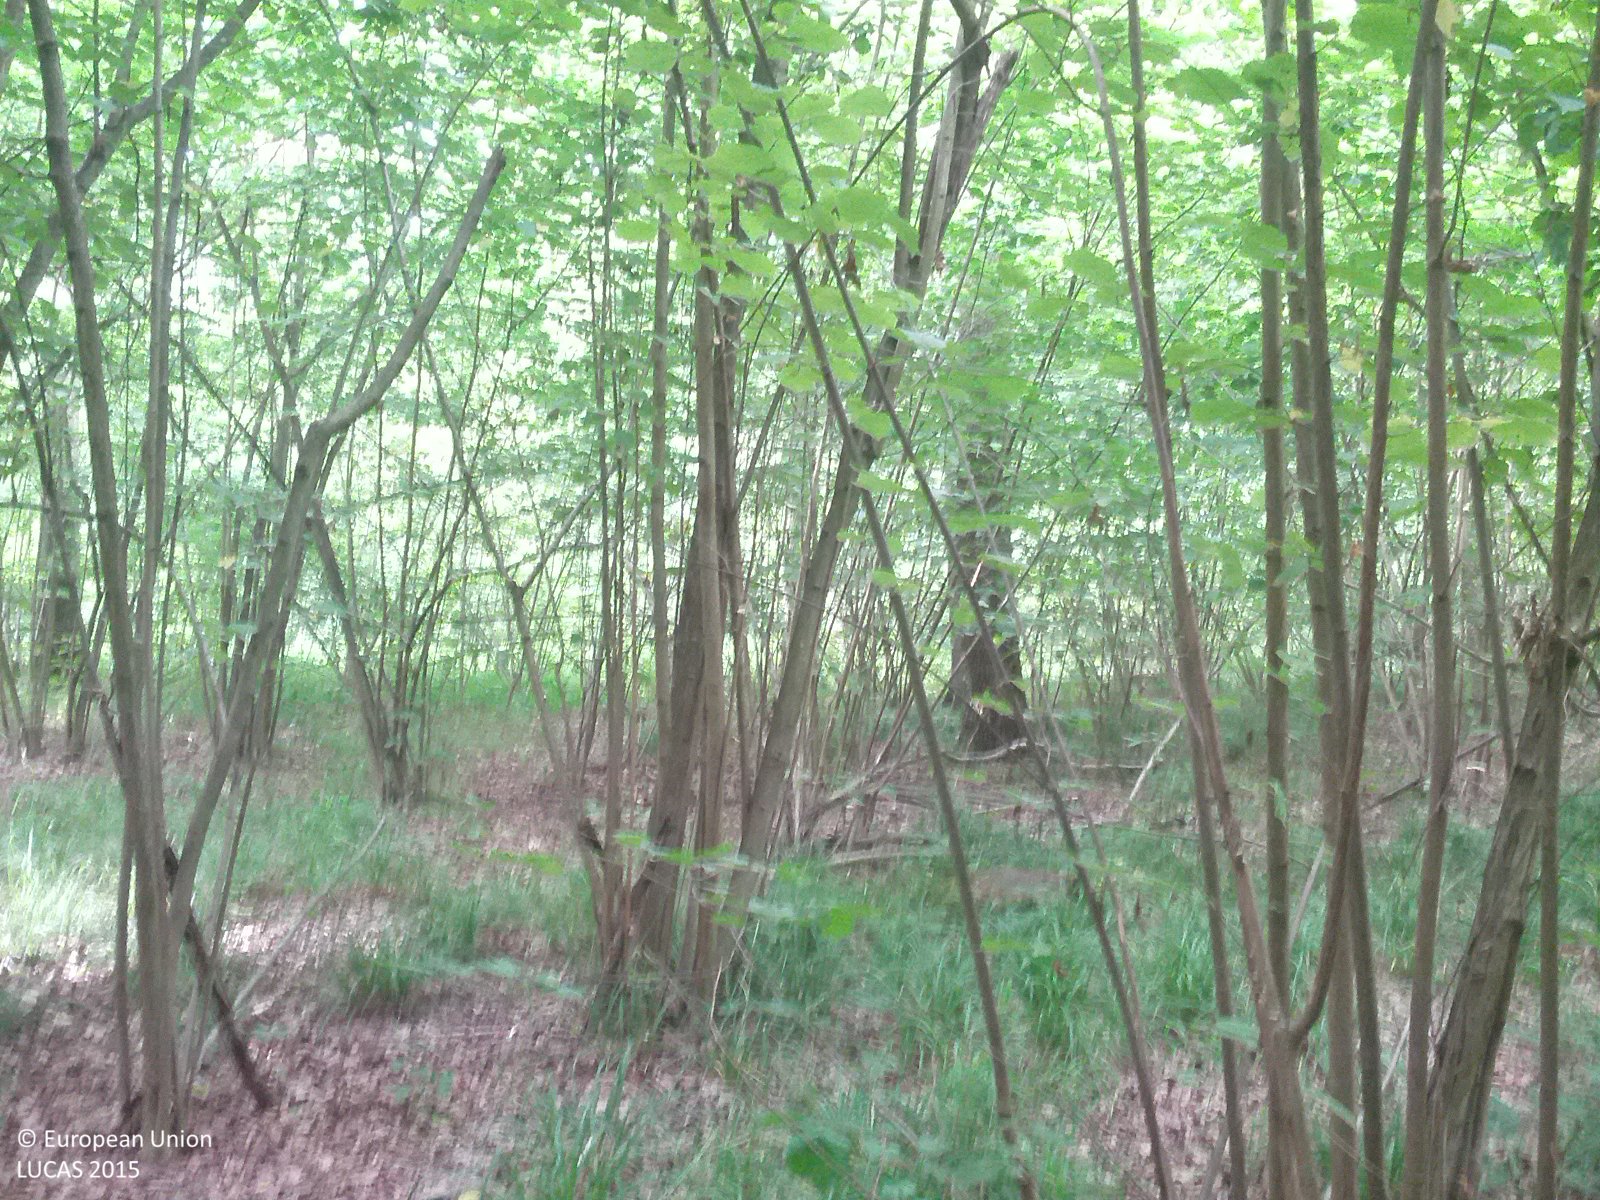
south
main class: Woodland
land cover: Broadleaved woodland
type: acidophilous oak and oak-birch forest
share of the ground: > 75 %
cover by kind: broadleaved forest trees 90 %, shrubs 5 %, herbaceous plants 5 %
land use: Forestry
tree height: > 5 m
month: July
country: AT
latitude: 48.6939
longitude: 16.5957
